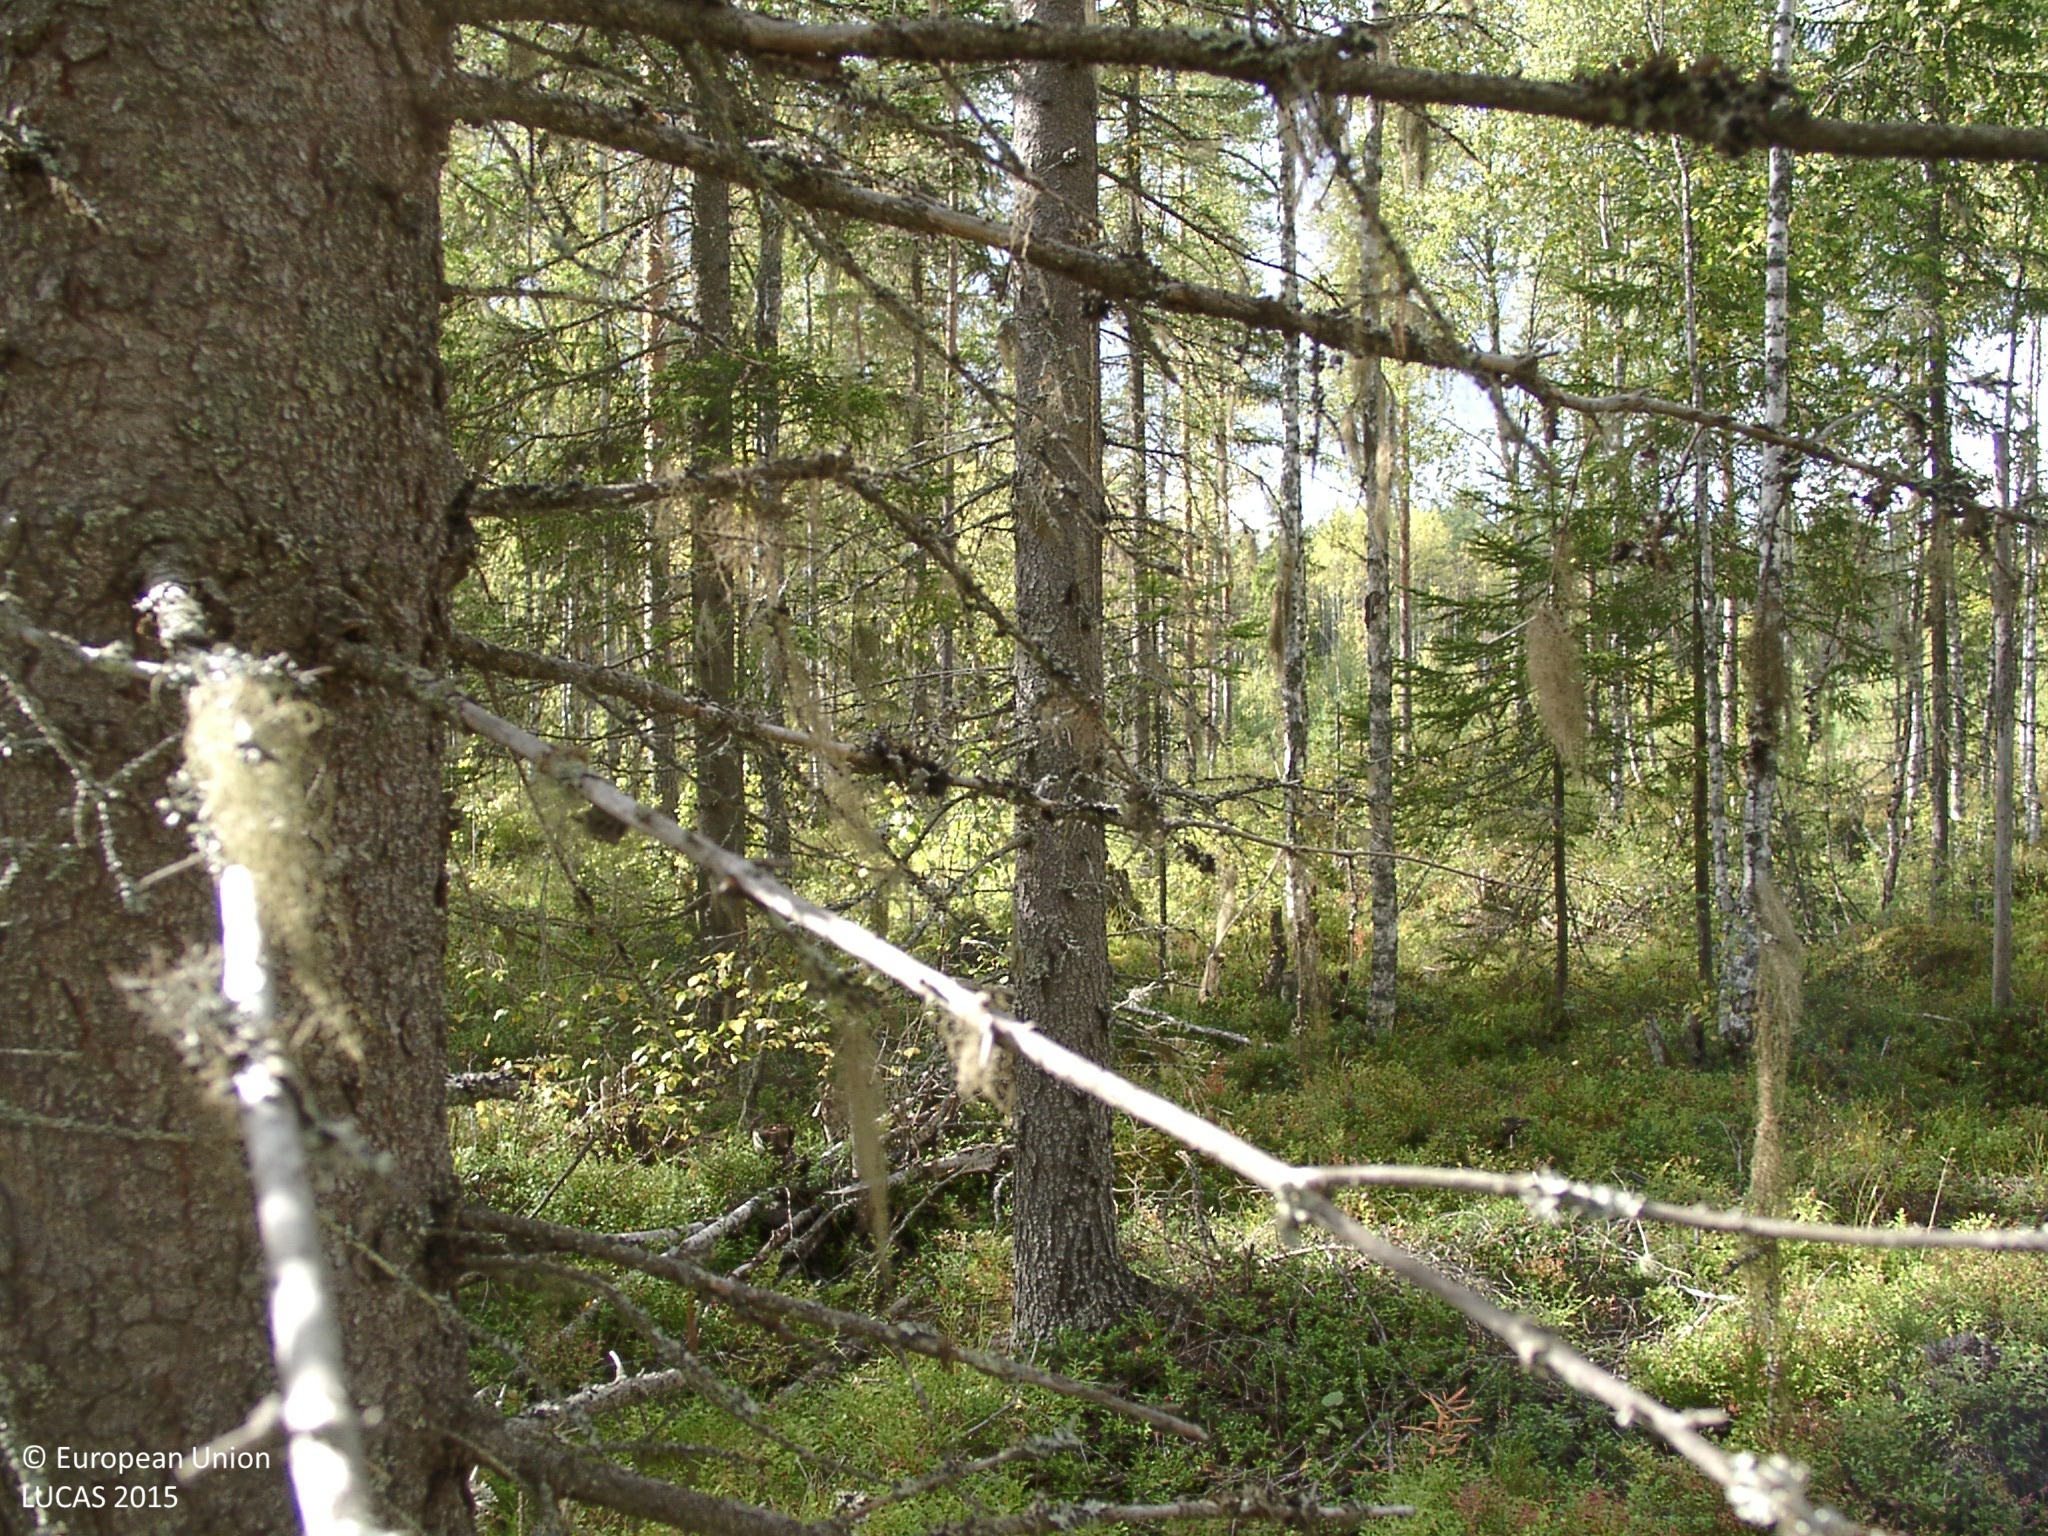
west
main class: Woodland
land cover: Other mixed woodland
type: boreal forest
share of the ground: 50 - 75 %
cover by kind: coniferous forest trees 40 %, shrubs 25 %, broadleaved forest trees 20 %, lichens and mosses 15 %
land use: Forestry
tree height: > 5 m
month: September
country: FI
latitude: 62.8741
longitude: 25.6622
